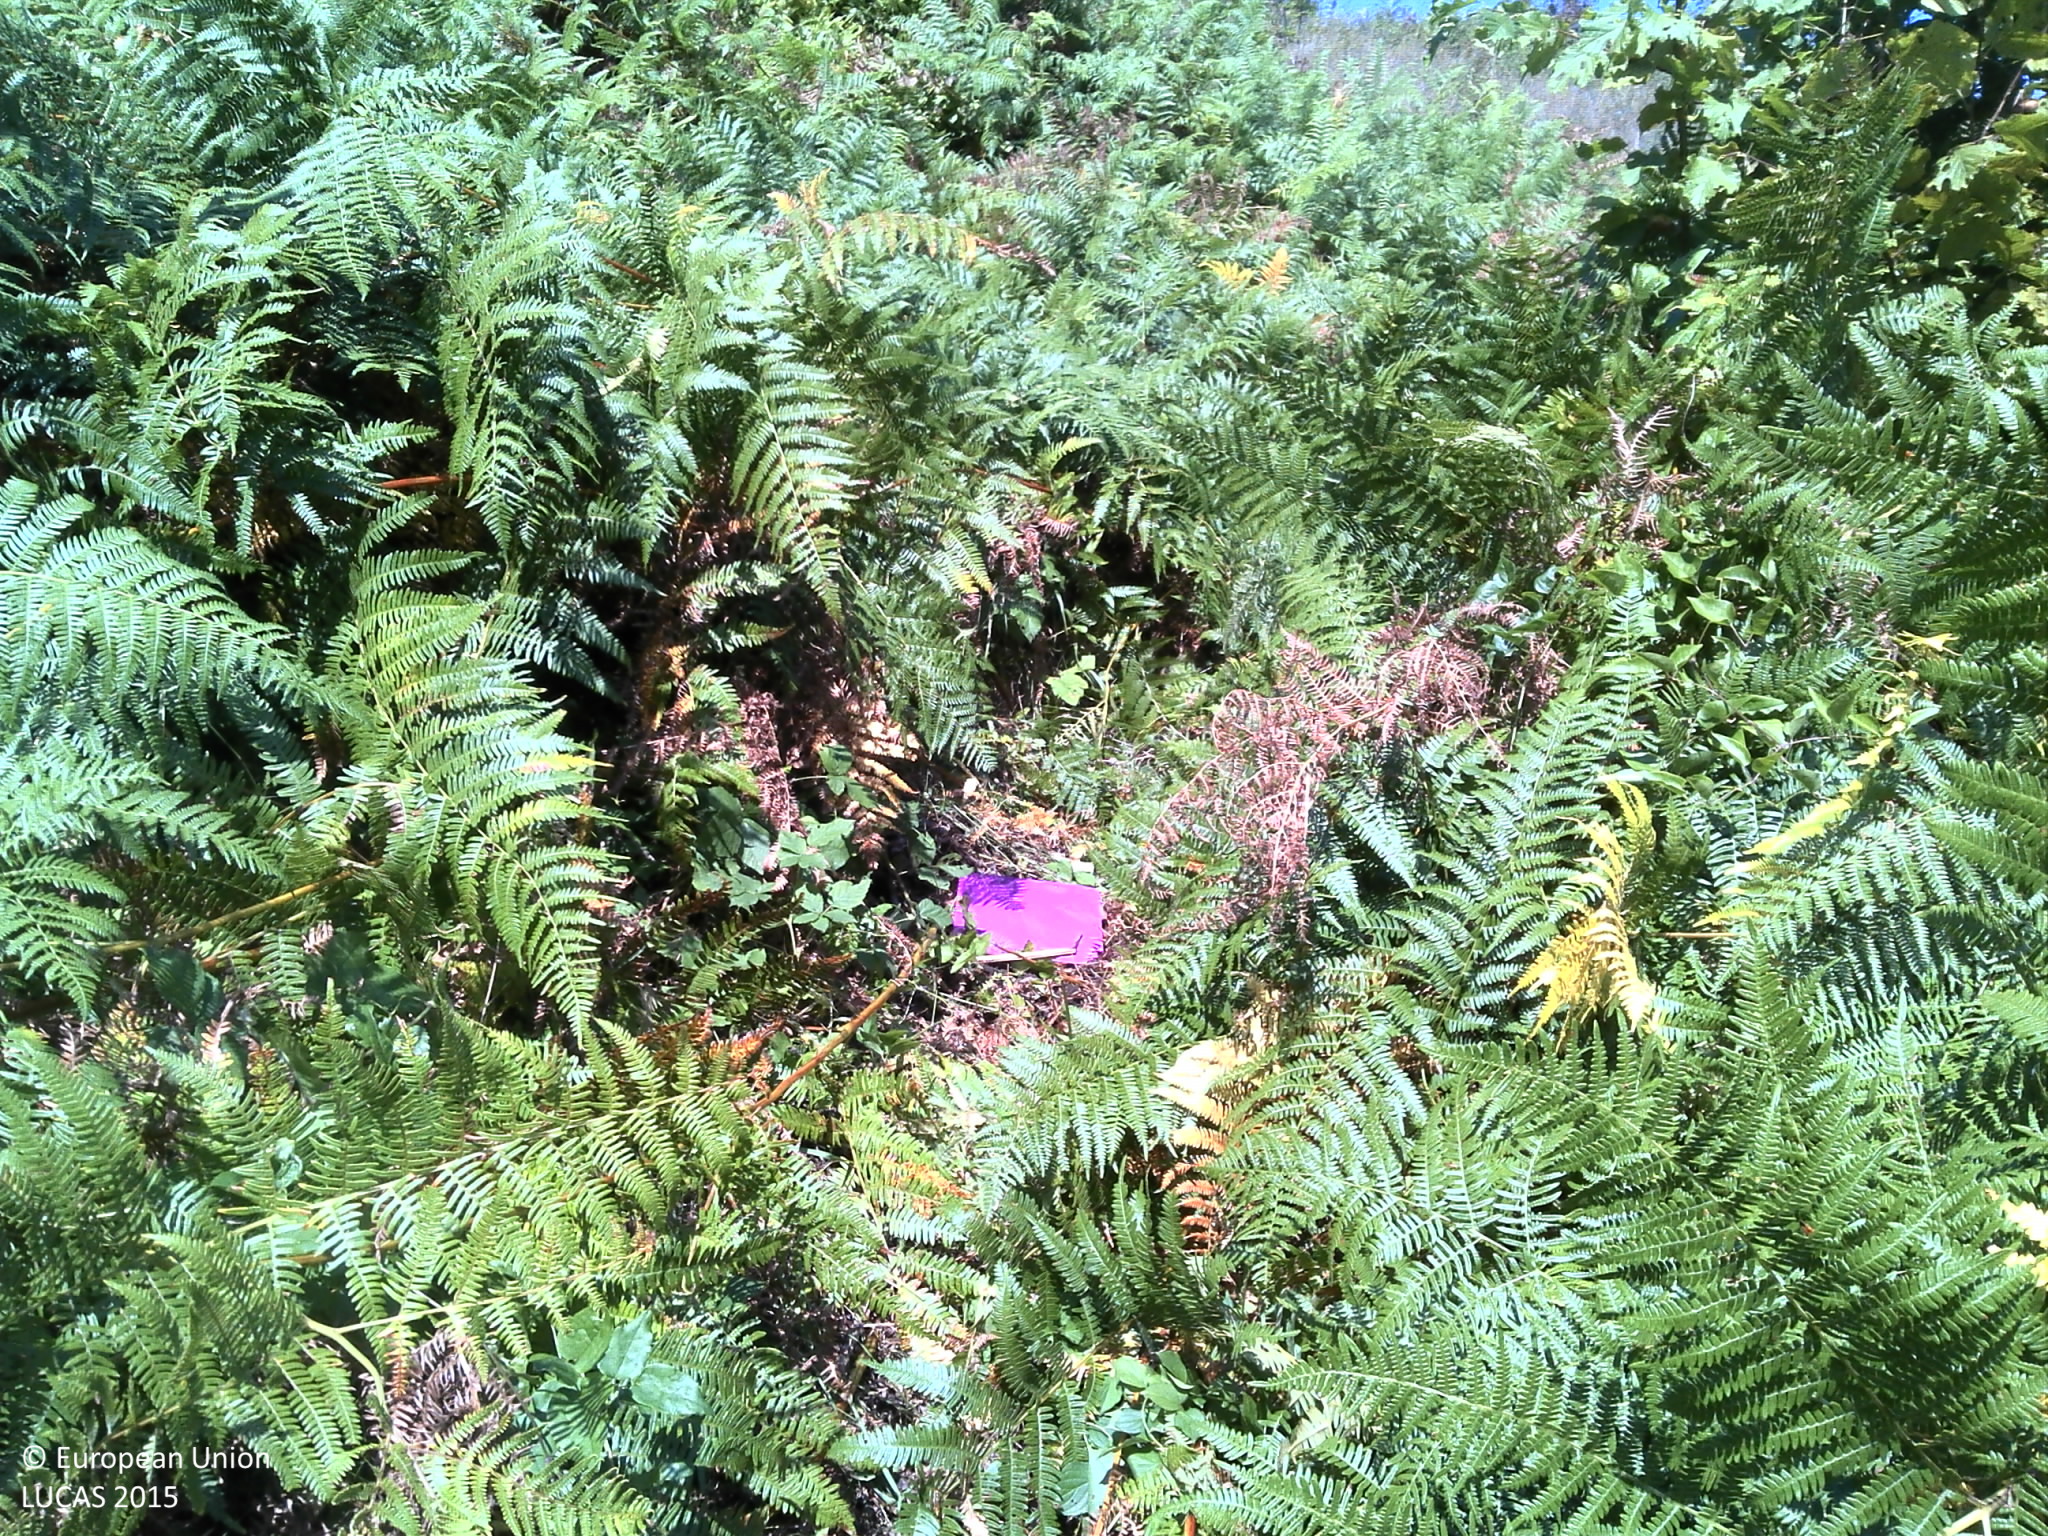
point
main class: Shrubland
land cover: Shrubland without tree cover
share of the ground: > 75 %
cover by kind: shrubs 100 %
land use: Semi-natural and natural areas not in use
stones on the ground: < 10 %
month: September
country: HR
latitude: 44.9564
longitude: 15.6358
